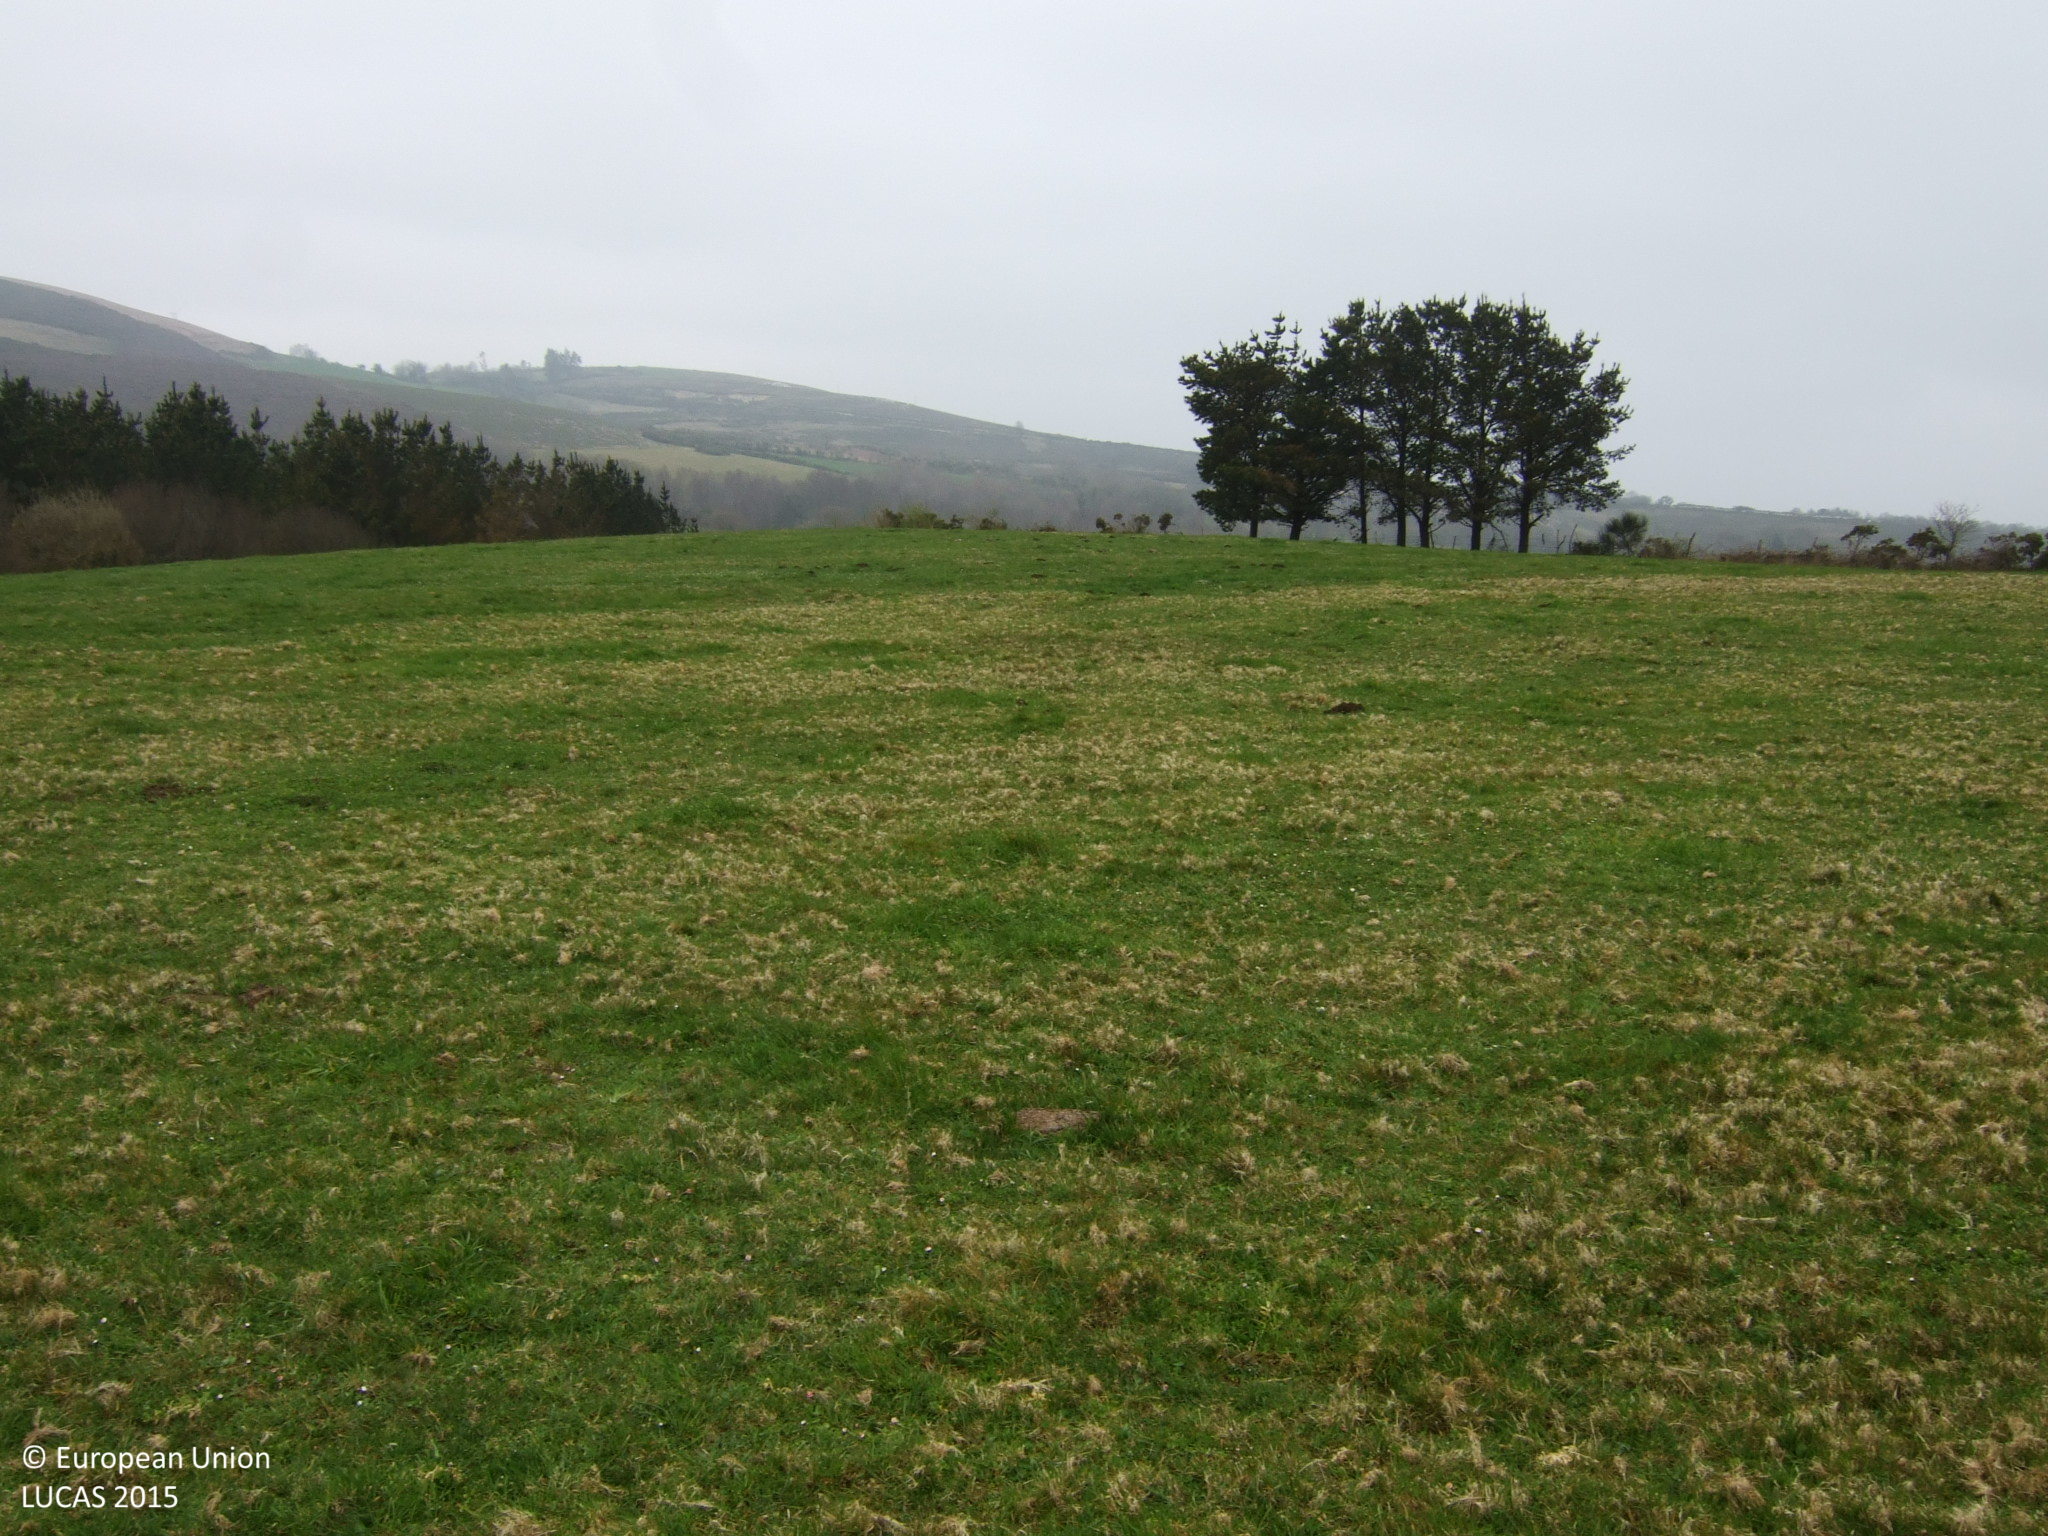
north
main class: Grassland
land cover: Grassland without tree/shrub cover
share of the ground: > 75 %
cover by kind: herbaceous plants 100 %
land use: Agriculture (excluding fallow land and kitchen gardens)
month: March
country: ES
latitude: 42.9673
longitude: -7.8753
